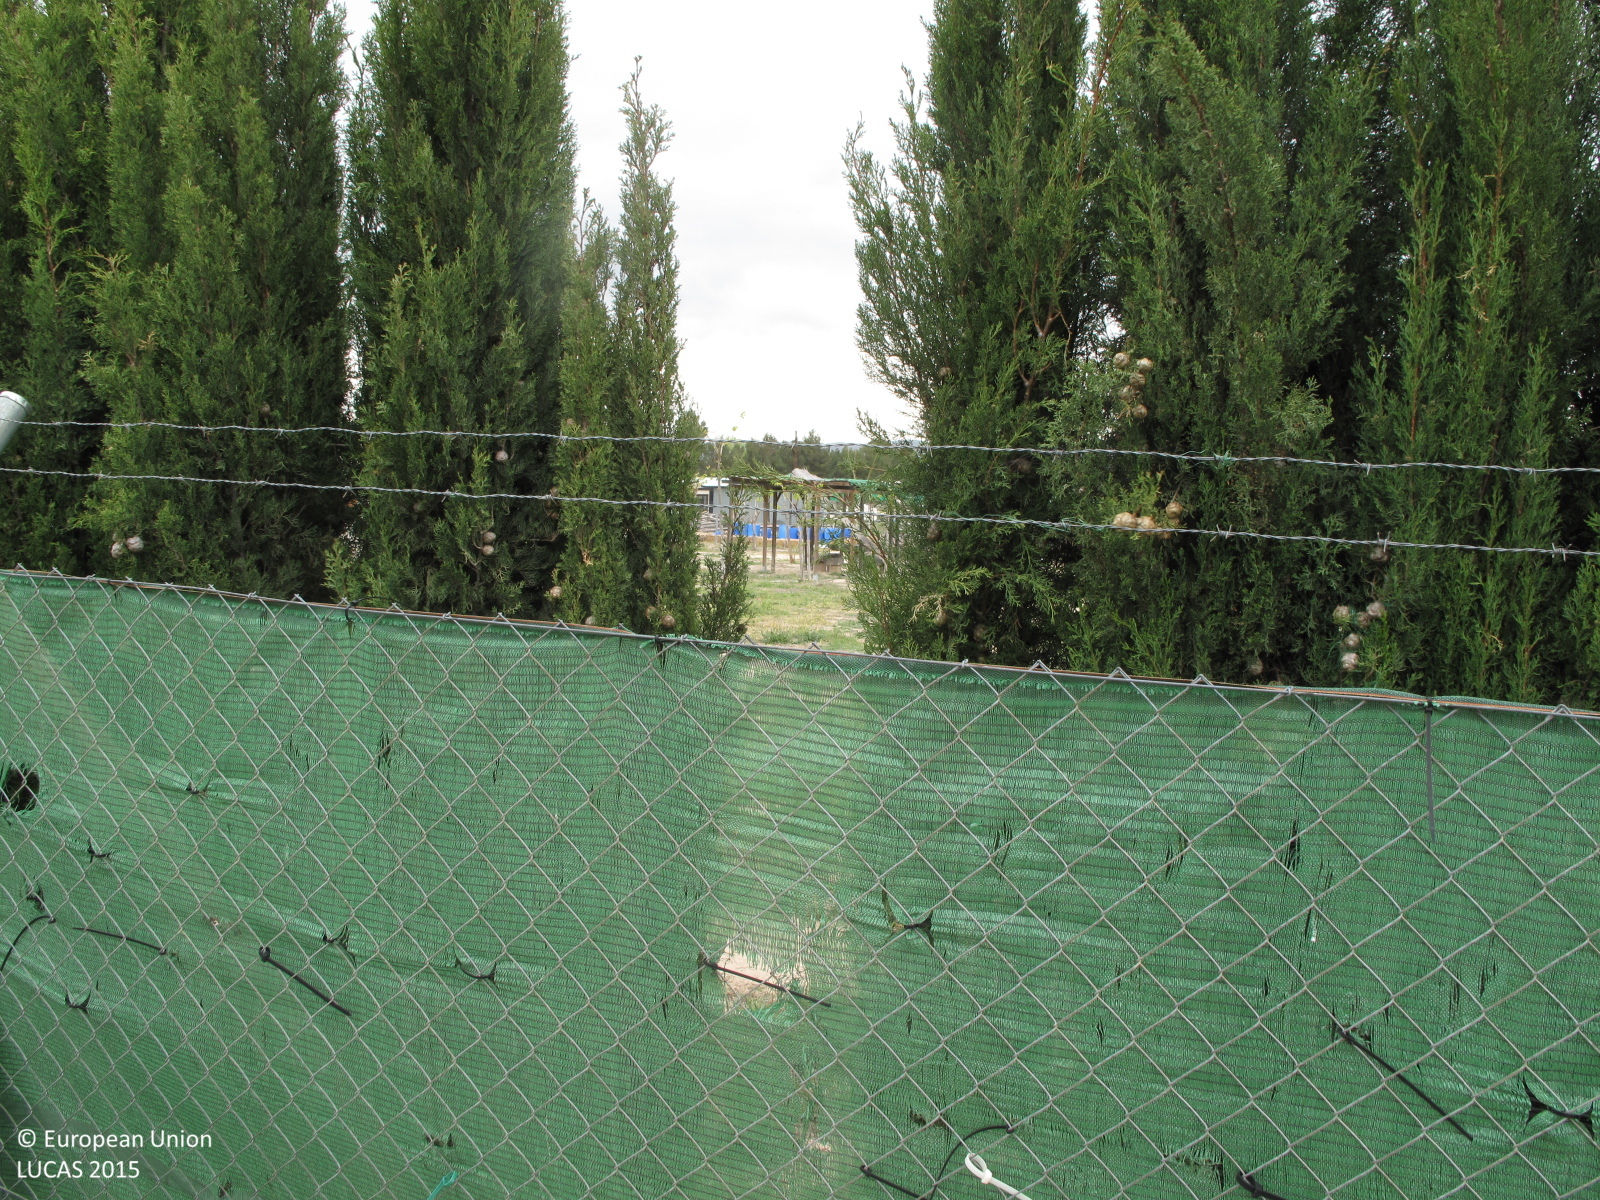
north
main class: Grassland
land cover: Spontaneously vegetated surfaces
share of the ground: 10 - 25 %
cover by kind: consolidated bare surface 75 %, herbaceous plants 25 %
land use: Residential
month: April
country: ES
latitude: 38.6316
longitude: -0.9380
